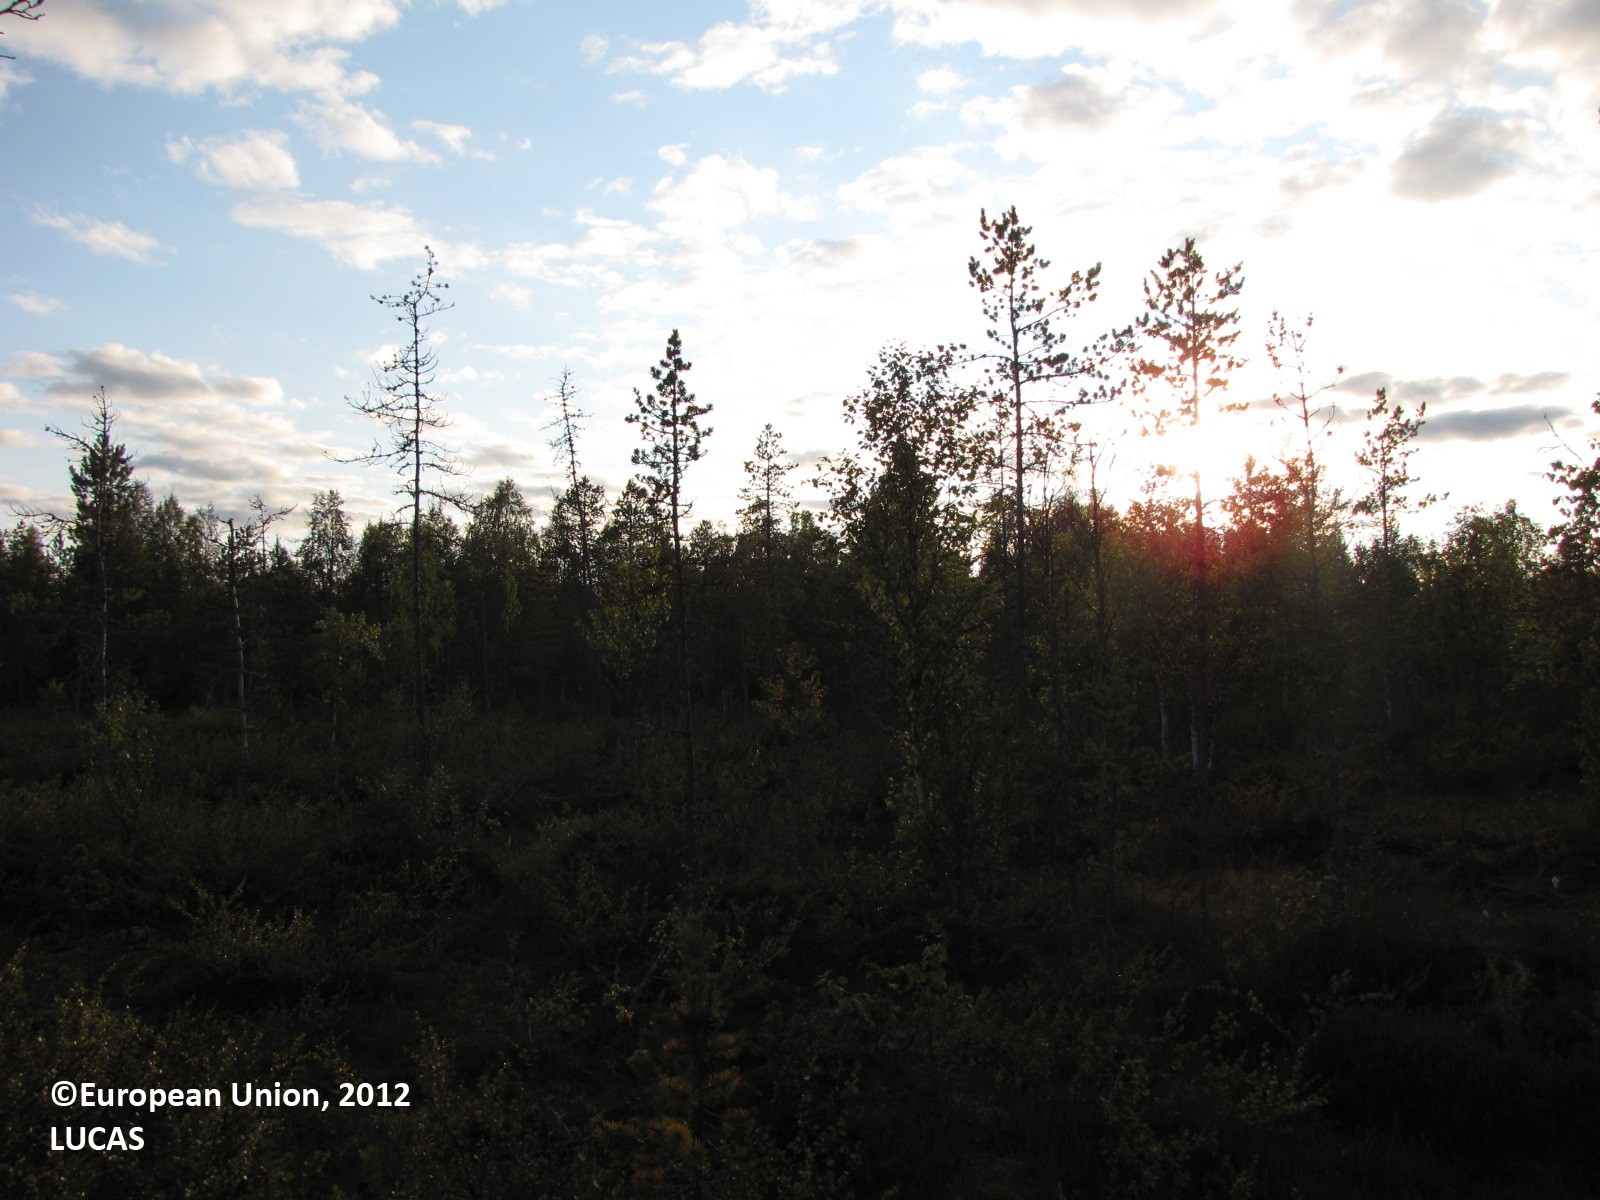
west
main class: Woodland
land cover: Pine dominated mixed woodland
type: boreal forest
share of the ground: 10 - 25 %
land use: Forestry
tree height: > 5 m
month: August
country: FI
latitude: 67.0580
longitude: 25.0591
